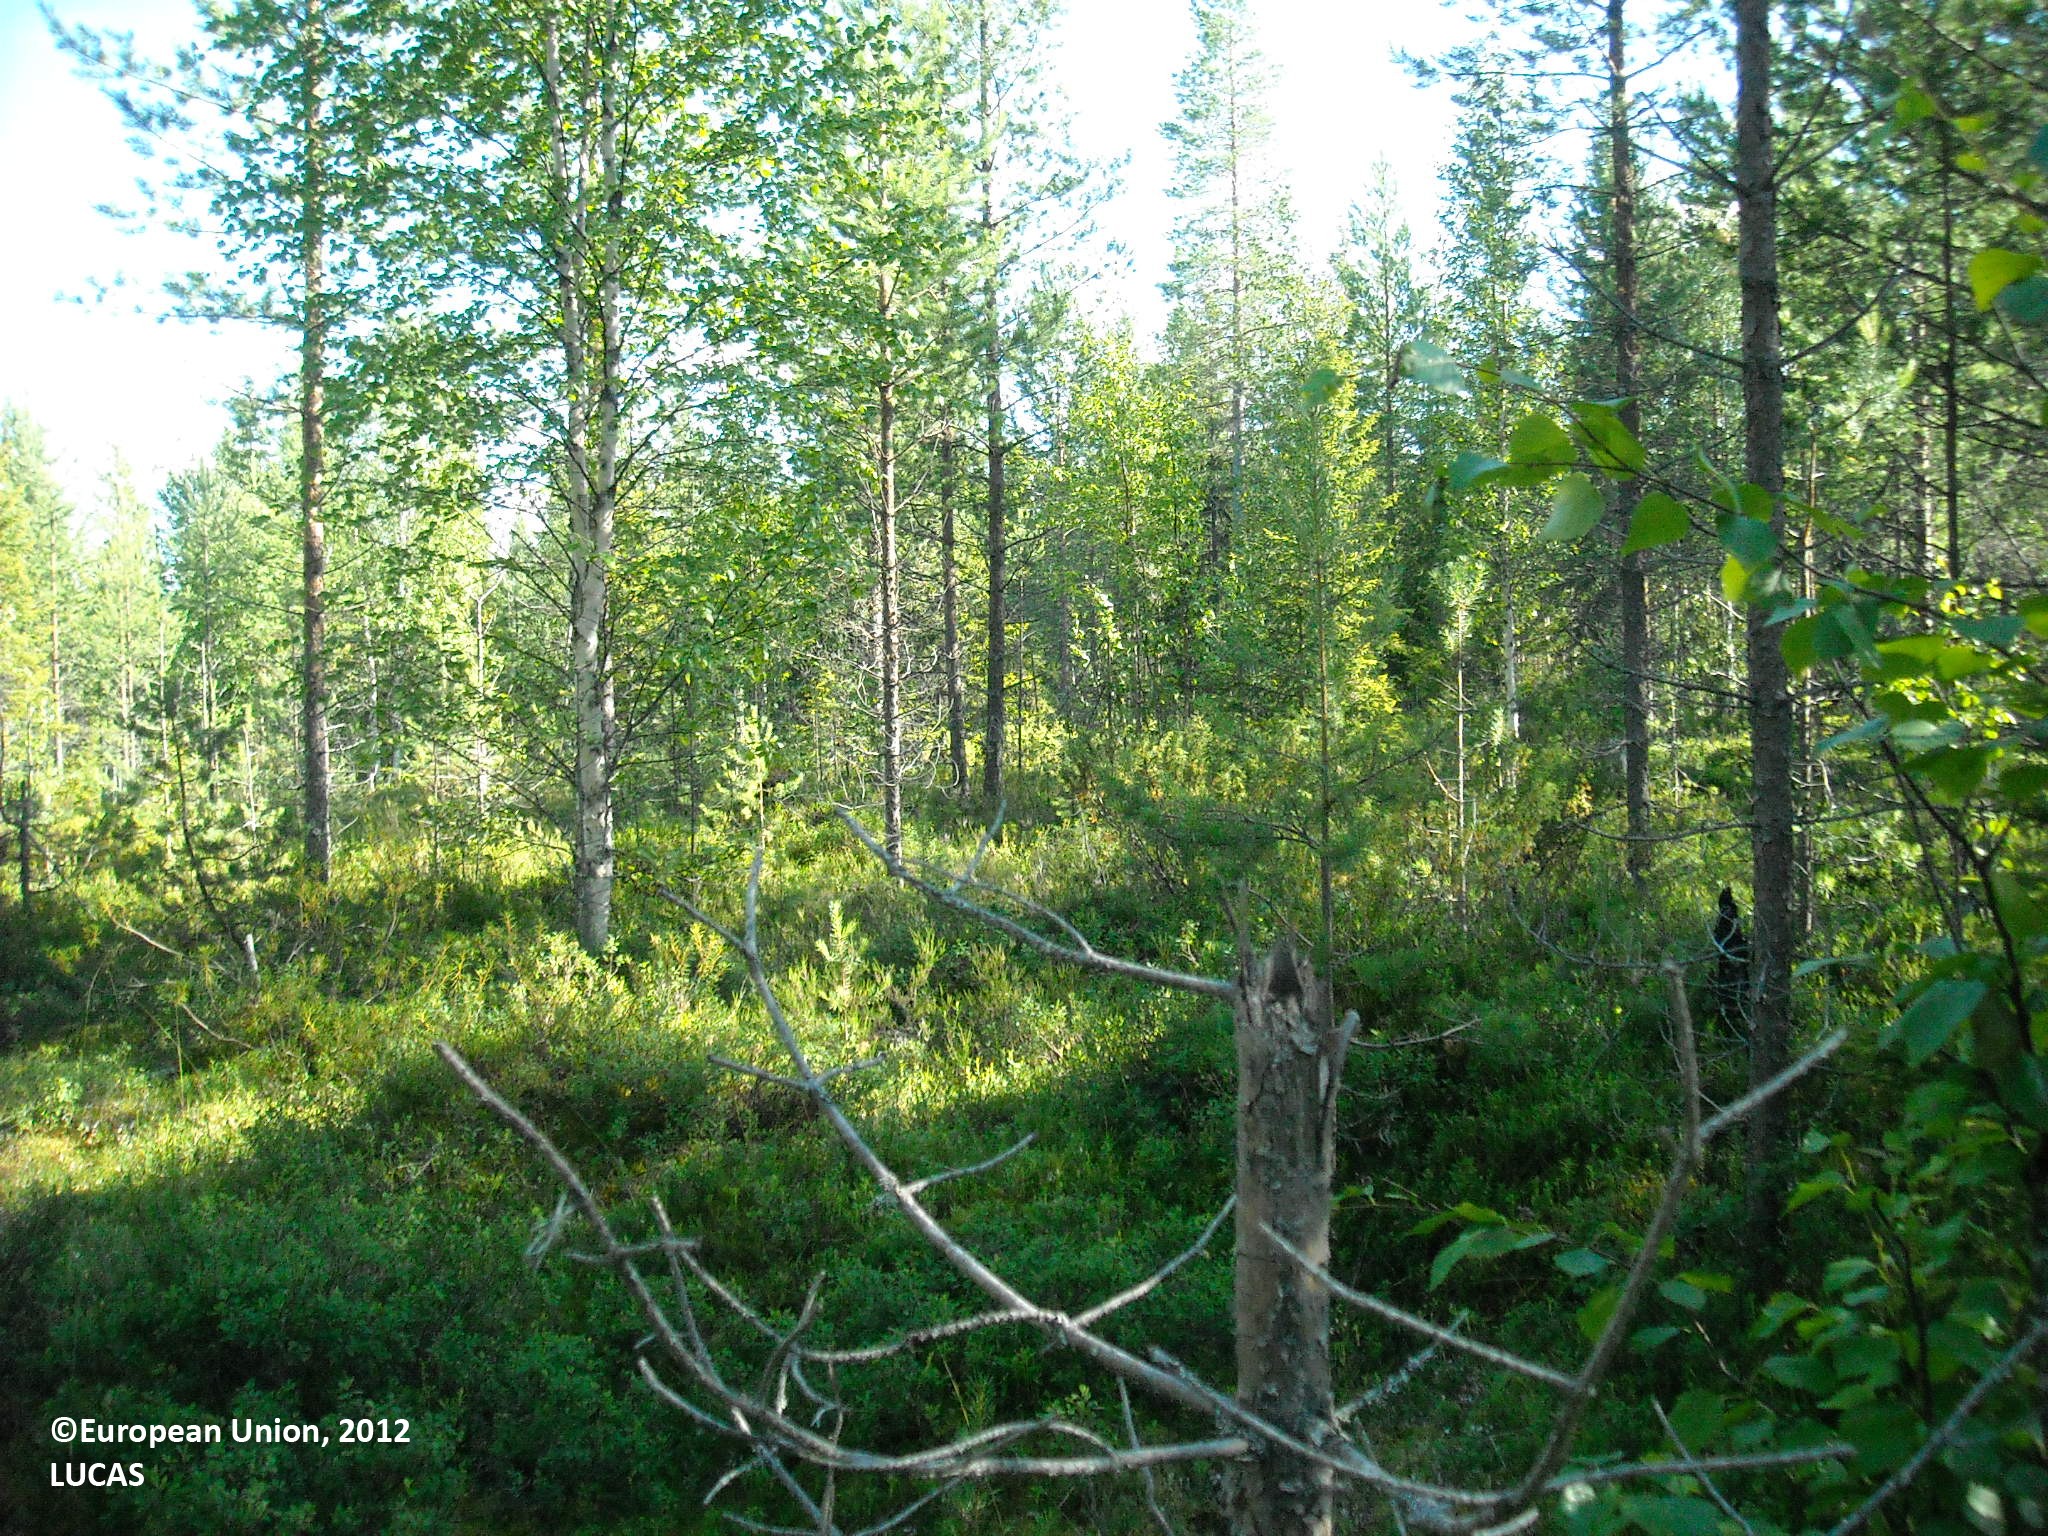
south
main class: Woodland
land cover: Other mixed woodland
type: boreal forest
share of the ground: 50 - 75 %
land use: Forestry
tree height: > 5 m
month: July
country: FI
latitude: 65.1731
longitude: 27.7511
